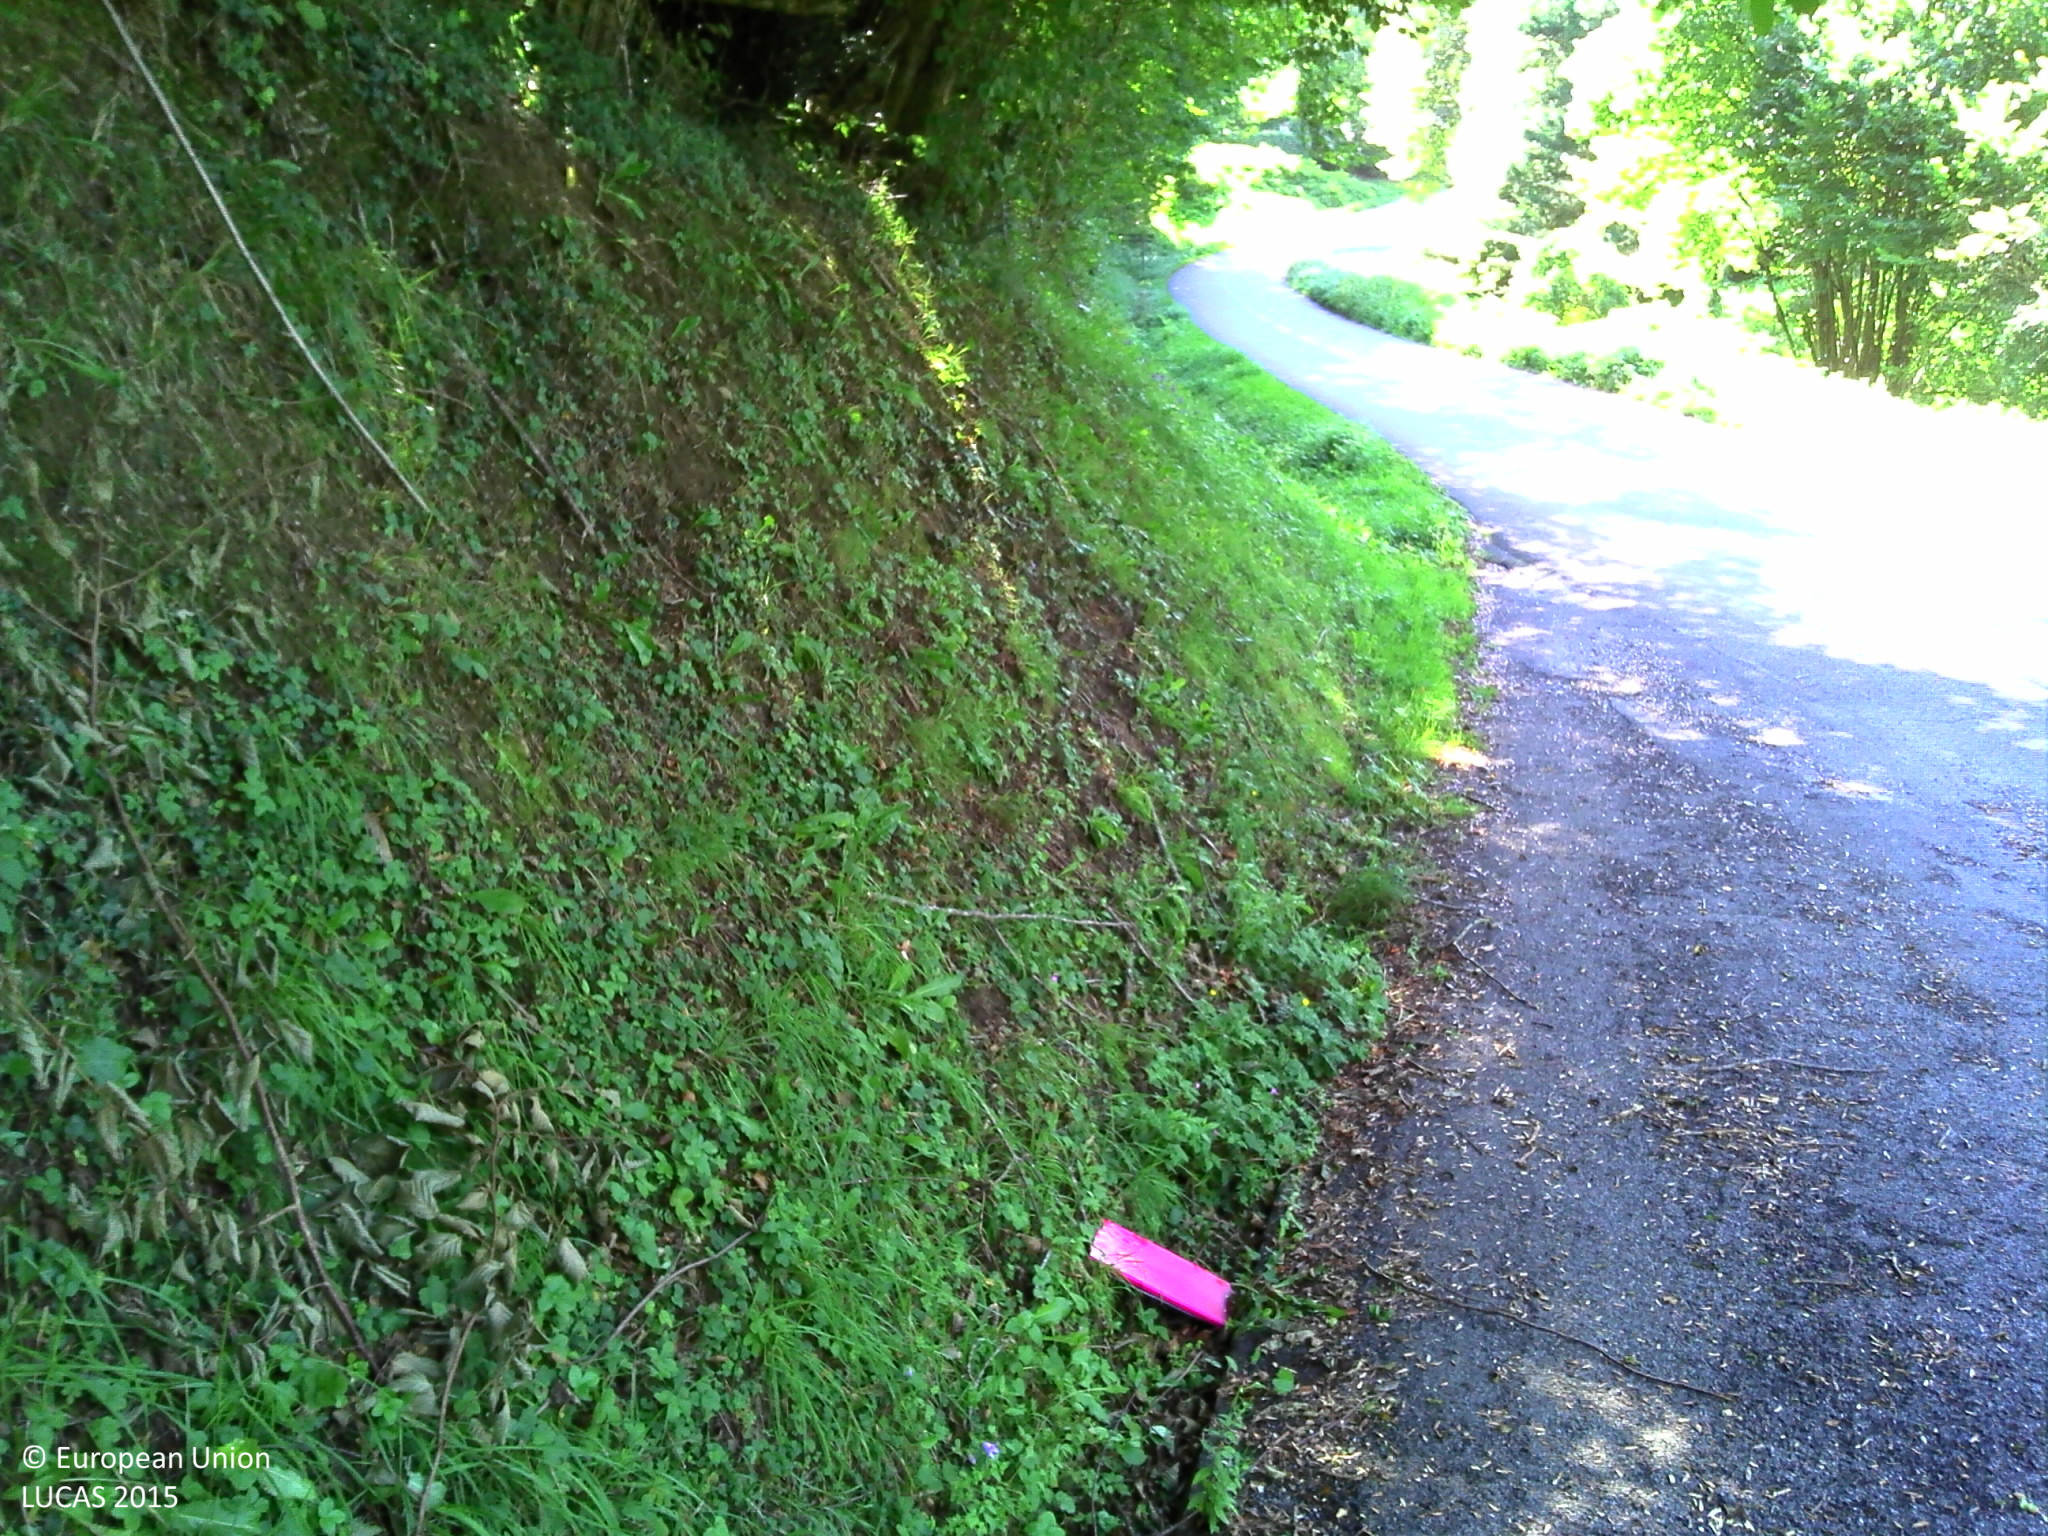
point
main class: Woodland
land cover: Broadleaved woodland
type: non-riverine alder, birch or aspen forest
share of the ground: > 75 %
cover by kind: broadleaved forest trees 65 %, shrubs 10 %, herbaceous plants 10 %, lichens and mosses 10 %, coniferous forest trees 5 %
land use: Forestry
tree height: > 5 m
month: September
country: FR
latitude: 43.1161
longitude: -0.4154
